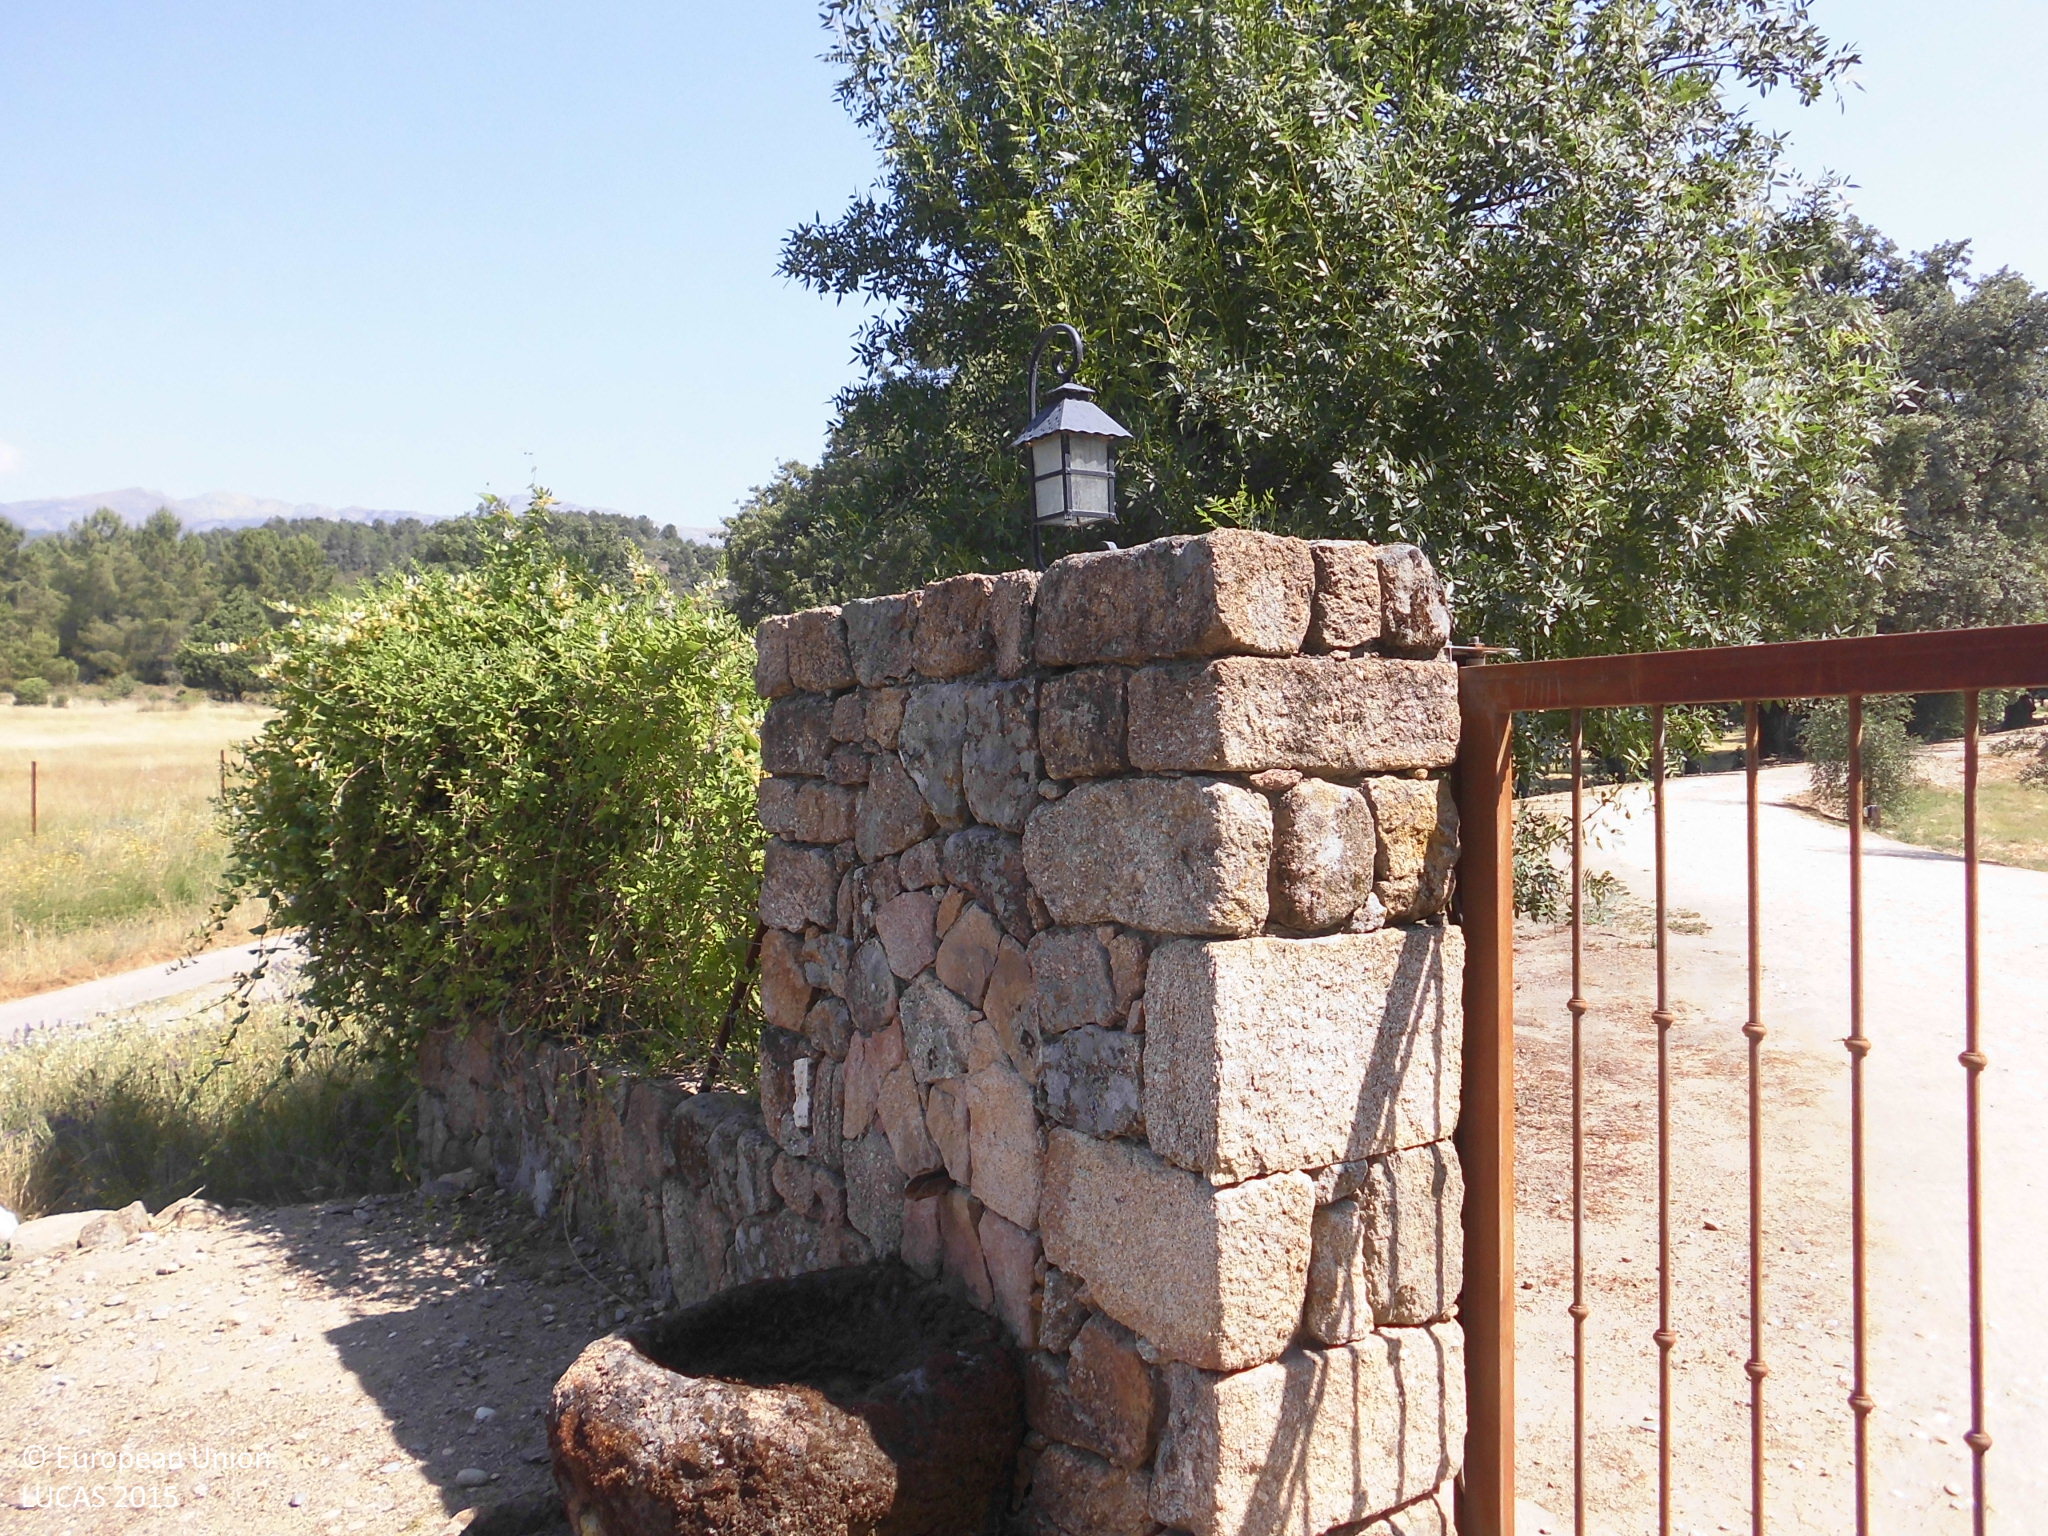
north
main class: Shrubland
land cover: Shrubland with sparse tree cover
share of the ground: 25 - 50 %
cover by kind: herbaceous plants 50 %, shrubs 45 %, broadleaved forest trees 5 %
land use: Agriculture (excluding fallow land and kitchen gardens)
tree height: > 5 m
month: June
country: ES
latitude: 40.1029
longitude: -5.4395
